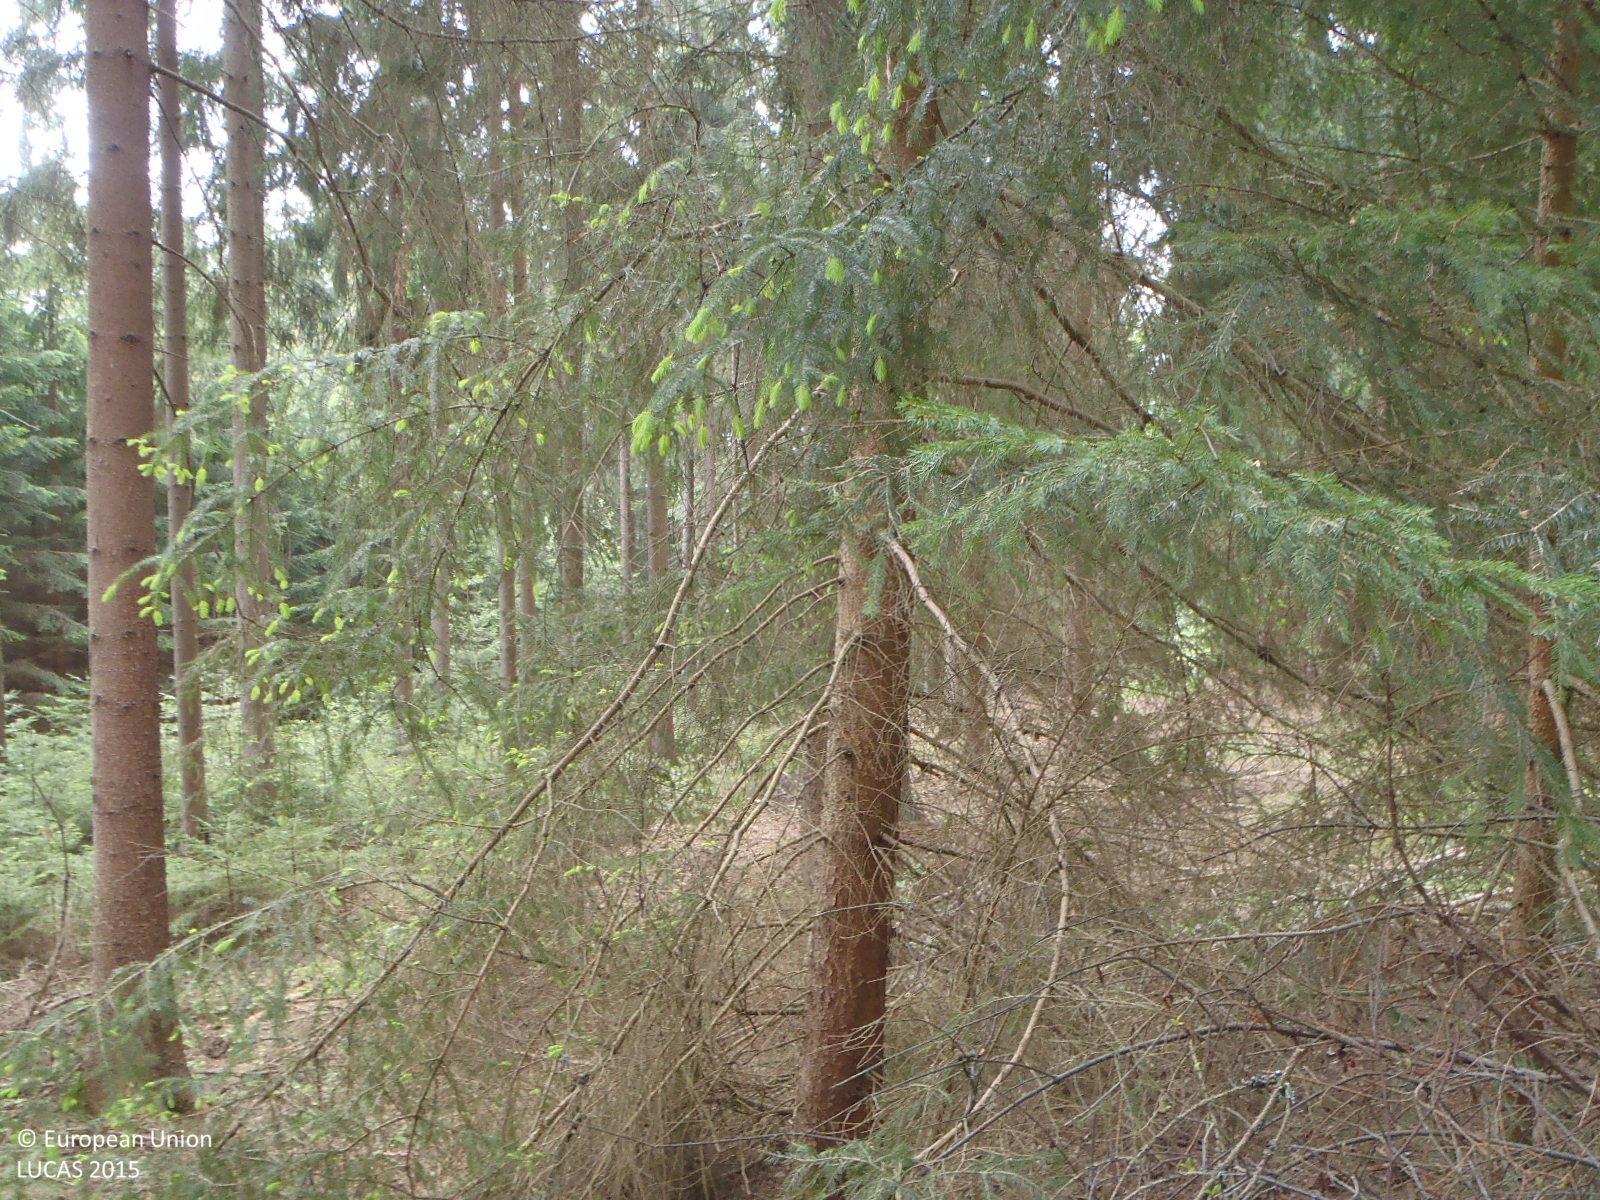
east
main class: Woodland
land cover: Spruce dominated coniferous woodland
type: hemiboreal forest and nemoral coniferous forest and mixed broadleaved-coniferous forest
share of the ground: > 75 %
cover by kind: coniferous forest trees 75 %, herbaceous plants 10 %, unconsolidated bare surface 10 %, broadleaved forest trees 5 %
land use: Forestry
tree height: > 5 m
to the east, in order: Spruce dominated coniferous woodland; Tracks; Spruce dominated coniferous woodland; Tracks; Spruce dominated coniferous woodland; Groves; Tracks; Grassland without tree/shrub cover
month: May
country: CZ
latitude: 49.0798
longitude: 15.0816
